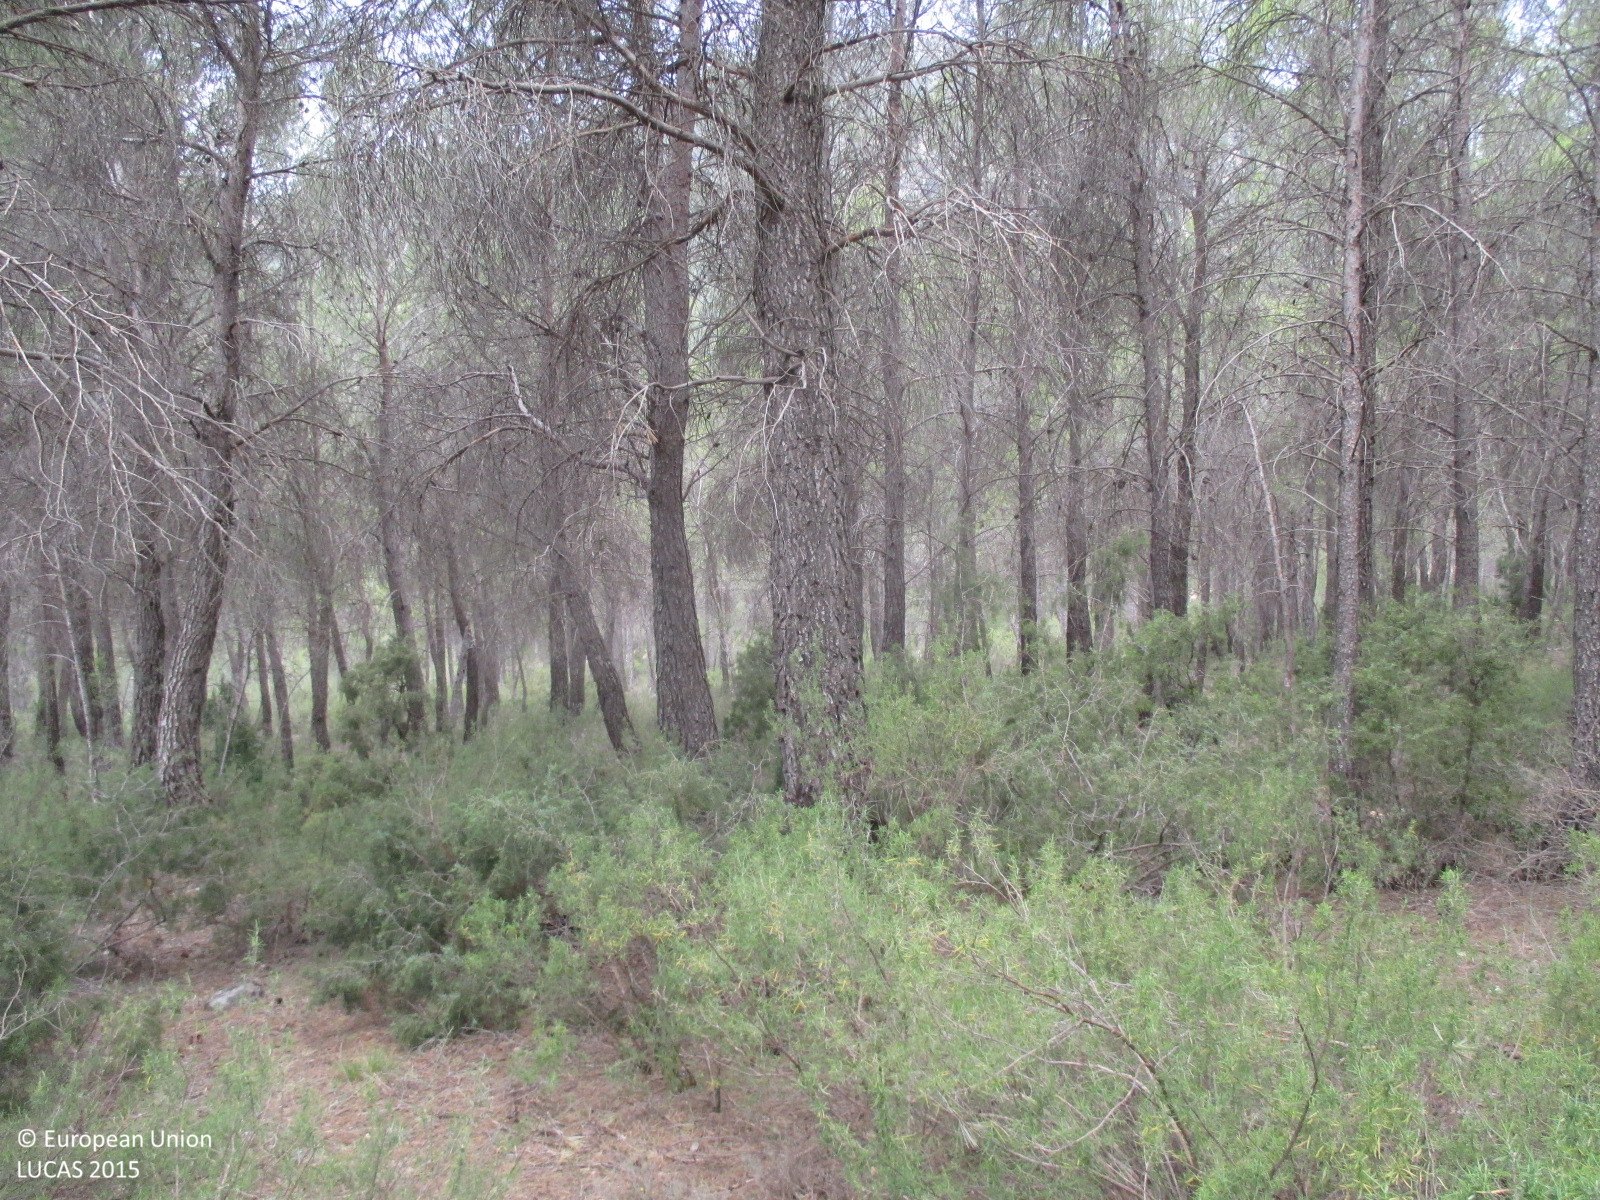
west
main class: Woodland
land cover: Pine dominated coniferous woodland
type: coniferous forest of the mediterranean region
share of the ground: > 75 %
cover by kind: coniferous forest trees 90 %, shrubs 10 %
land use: Forestry
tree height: > 5 m
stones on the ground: < 10 %
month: July
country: ES
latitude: 37.9279
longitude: -2.4943
